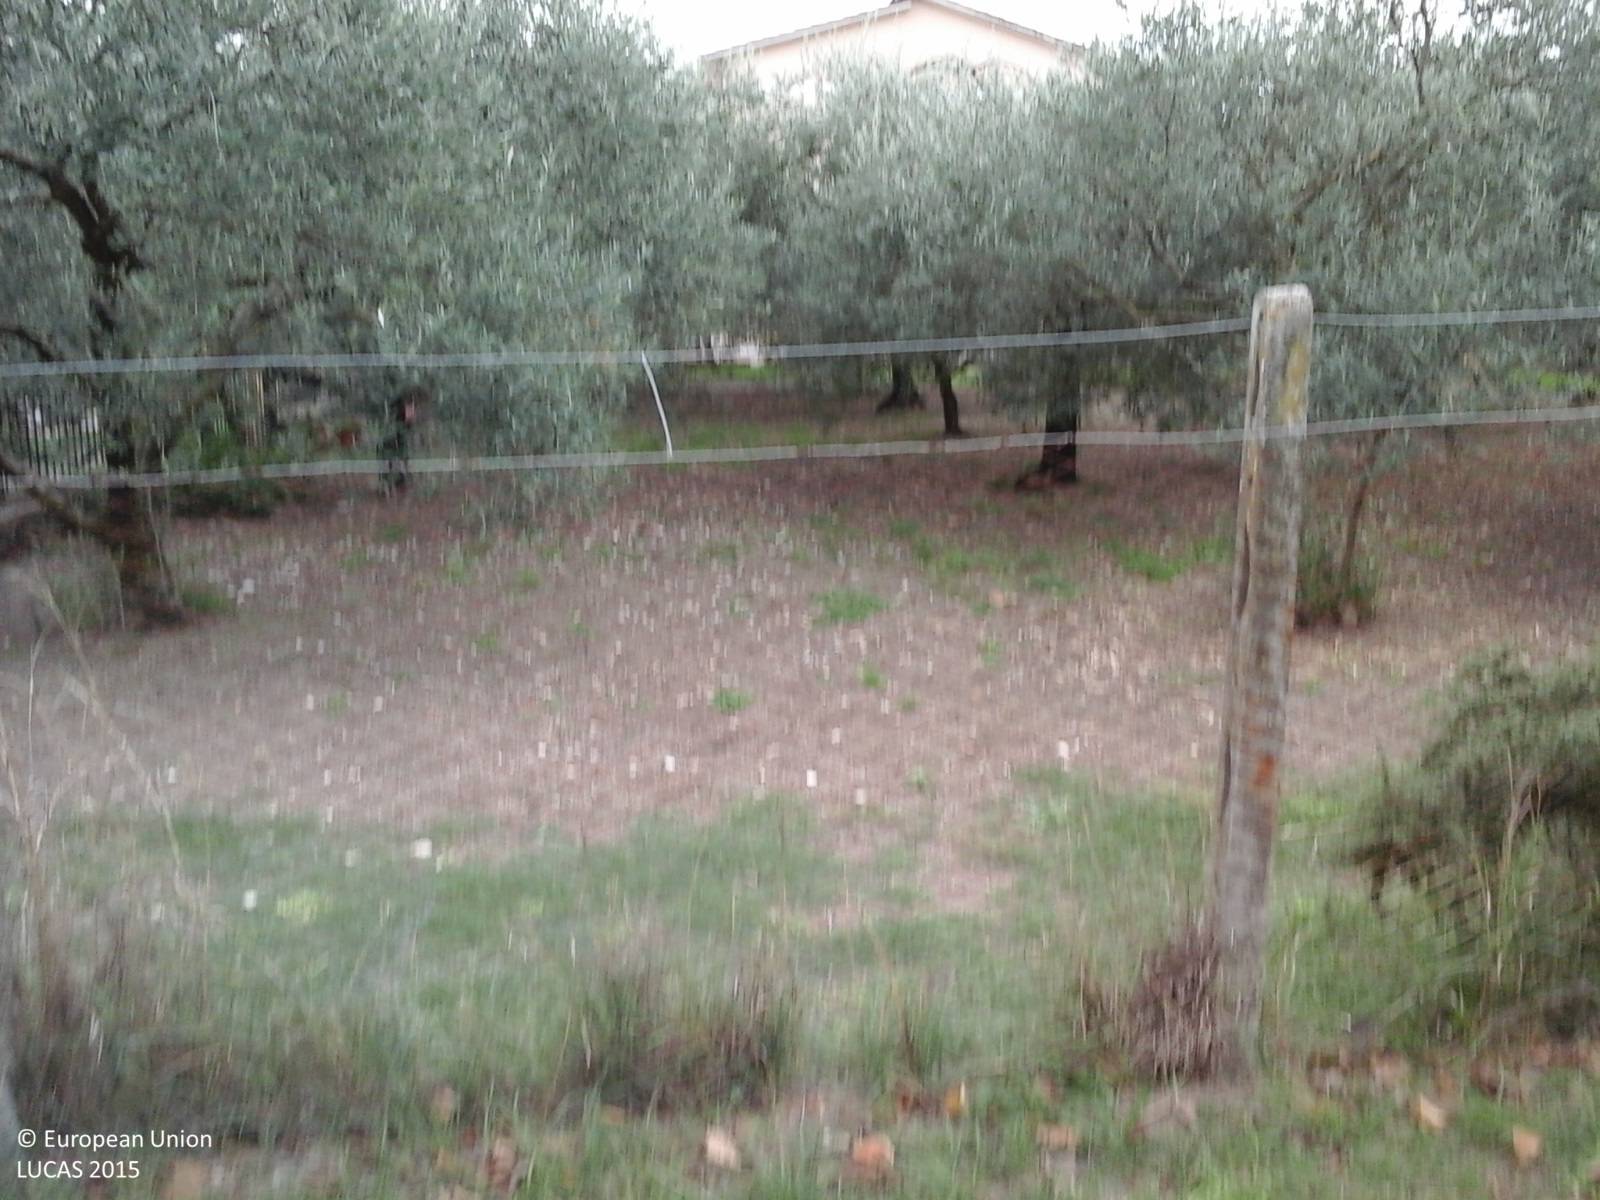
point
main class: Cropland
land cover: Olive groves
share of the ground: > 75 %
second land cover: Other bare soil
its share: > 75 %
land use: Kitchen garden
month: September
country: IT
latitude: 42.3177
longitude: 12.4304
